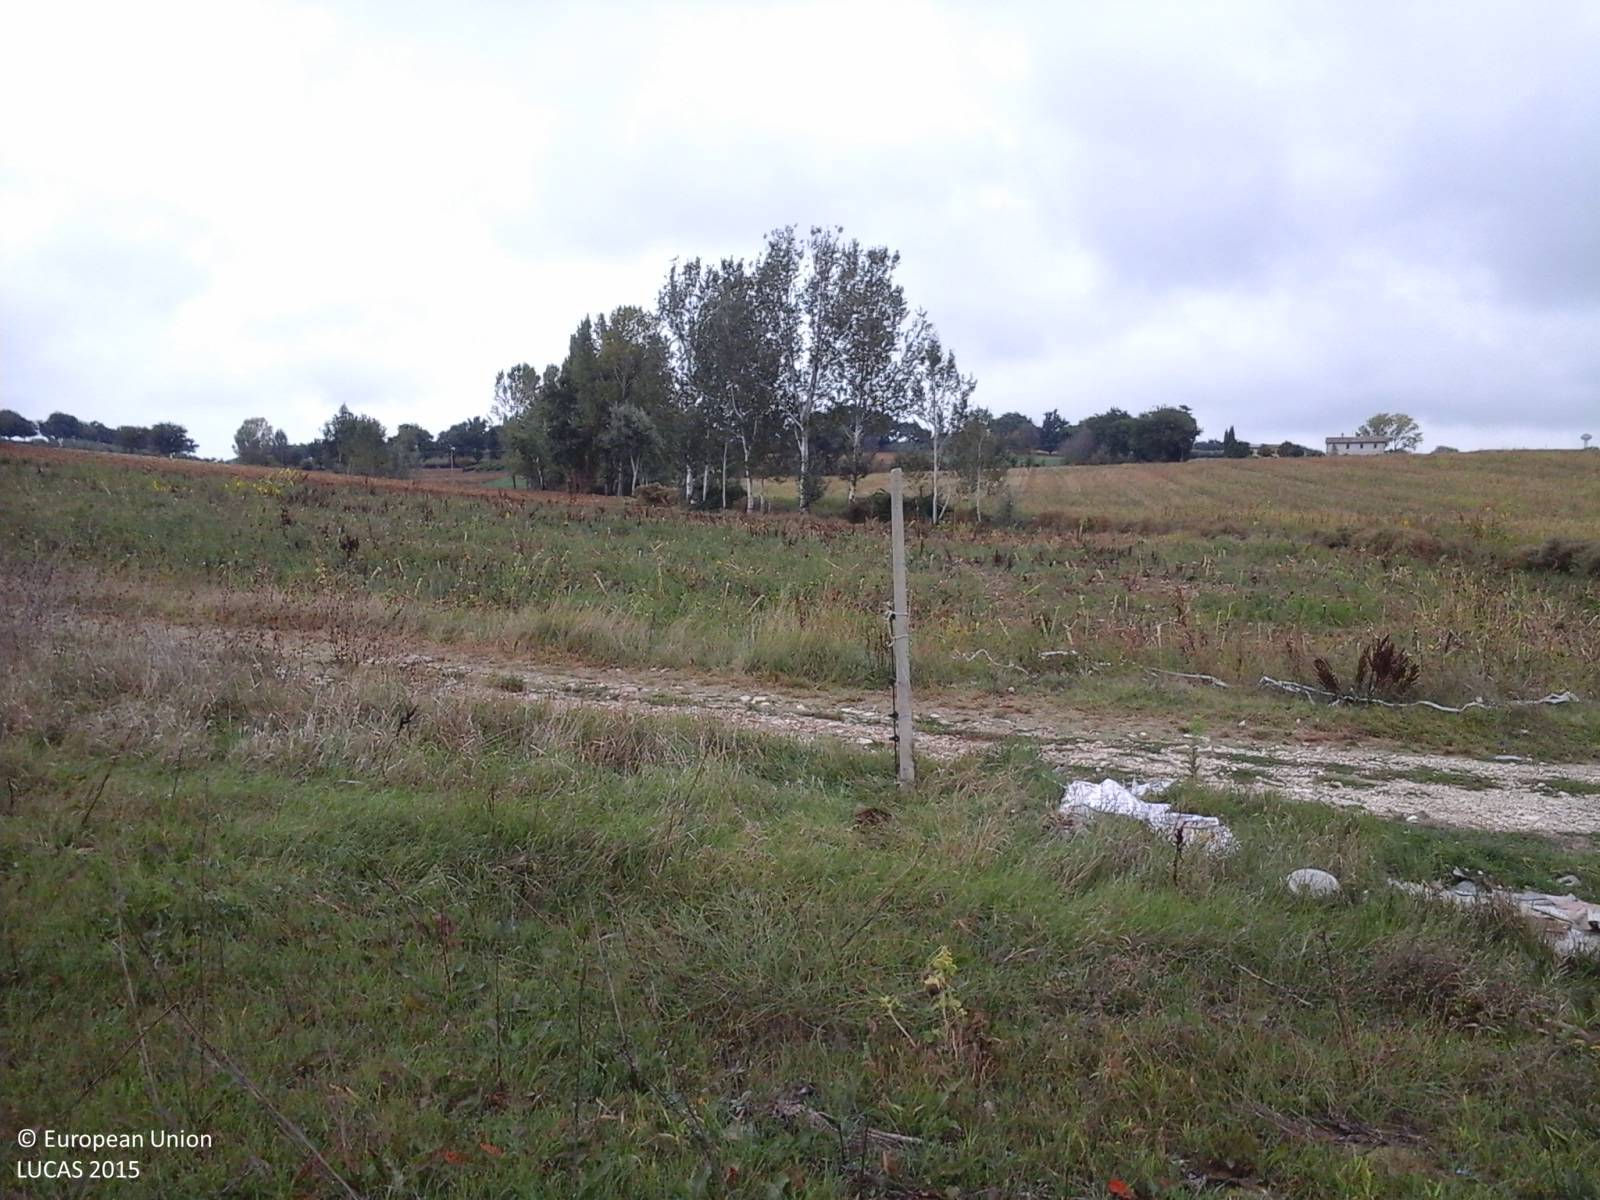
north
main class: Grassland
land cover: Grassland without tree/shrub cover
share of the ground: > 75 %
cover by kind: herbaceous plants 100 %
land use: Agriculture (excluding fallow land and kitchen gardens)
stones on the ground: 10 - 25 %
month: September
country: IT
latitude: 42.8730
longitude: 12.6240
